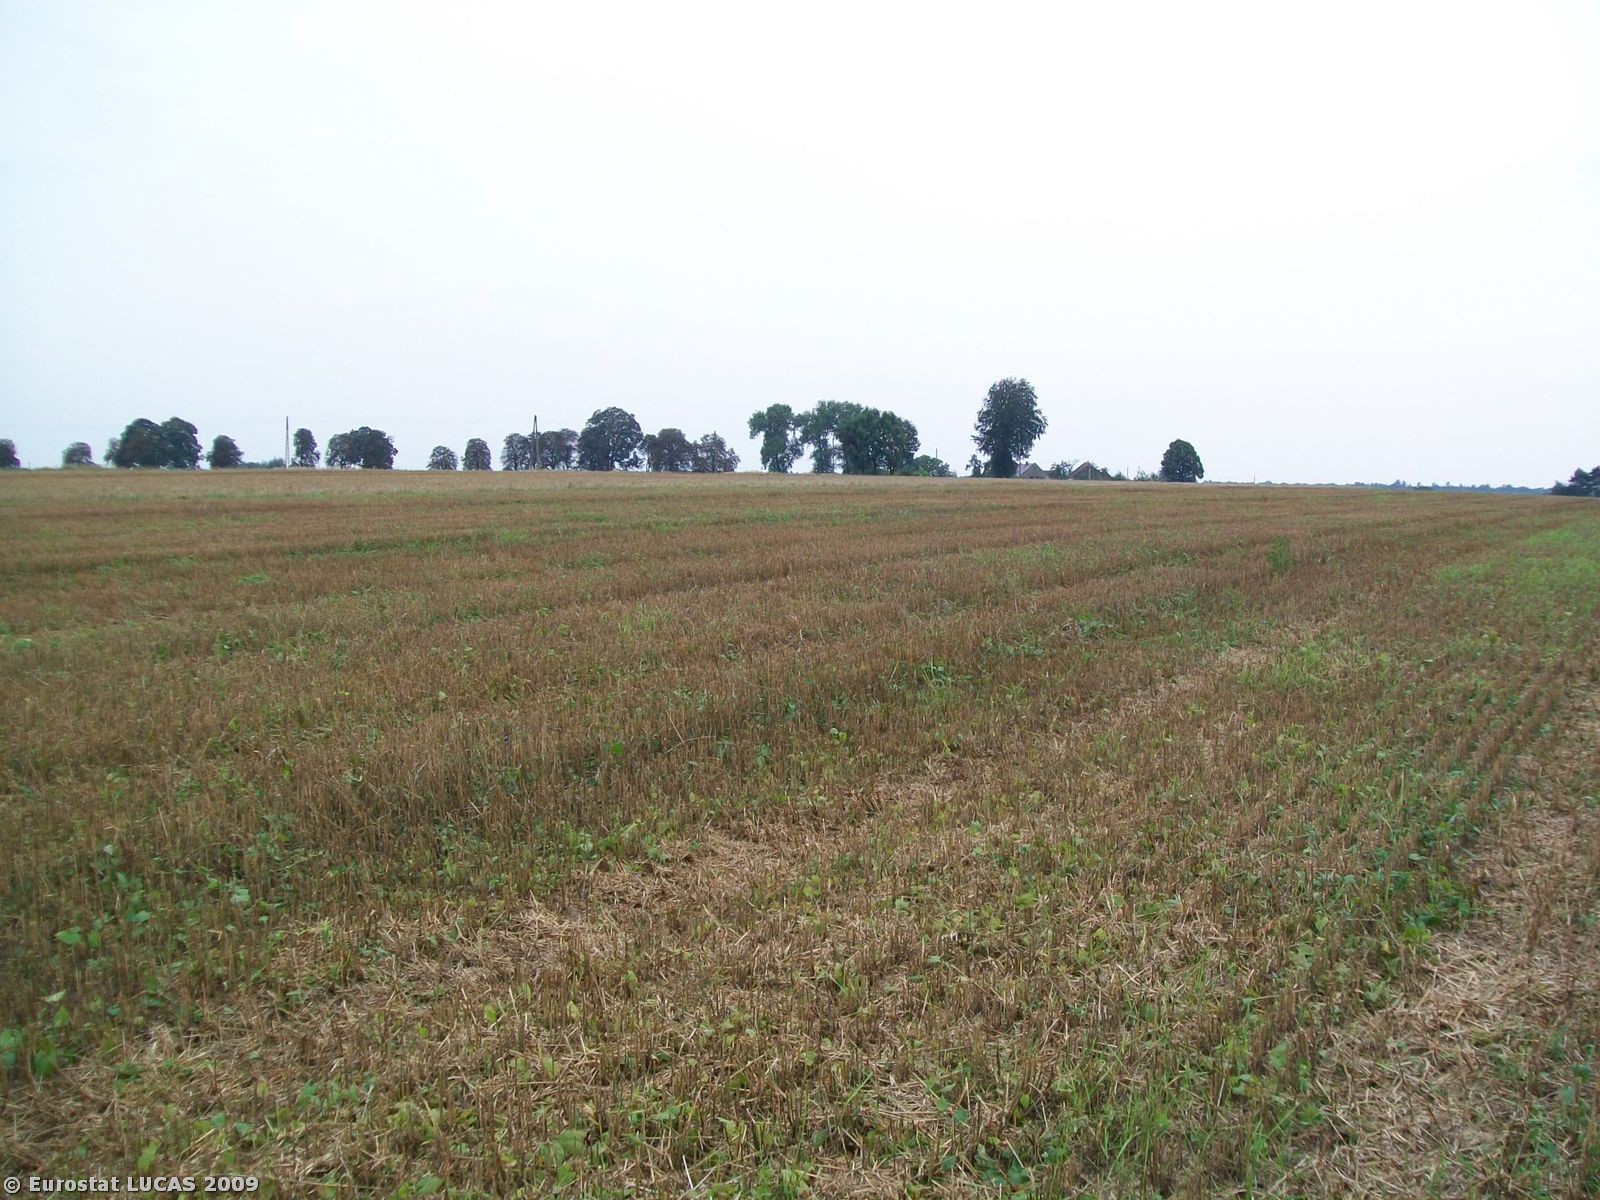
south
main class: Cropland
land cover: Common wheat
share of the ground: < 10 %
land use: Agriculture (excluding fallow land and kitchen gardens)
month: August
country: PL
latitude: 51.0995
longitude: 17.9411
